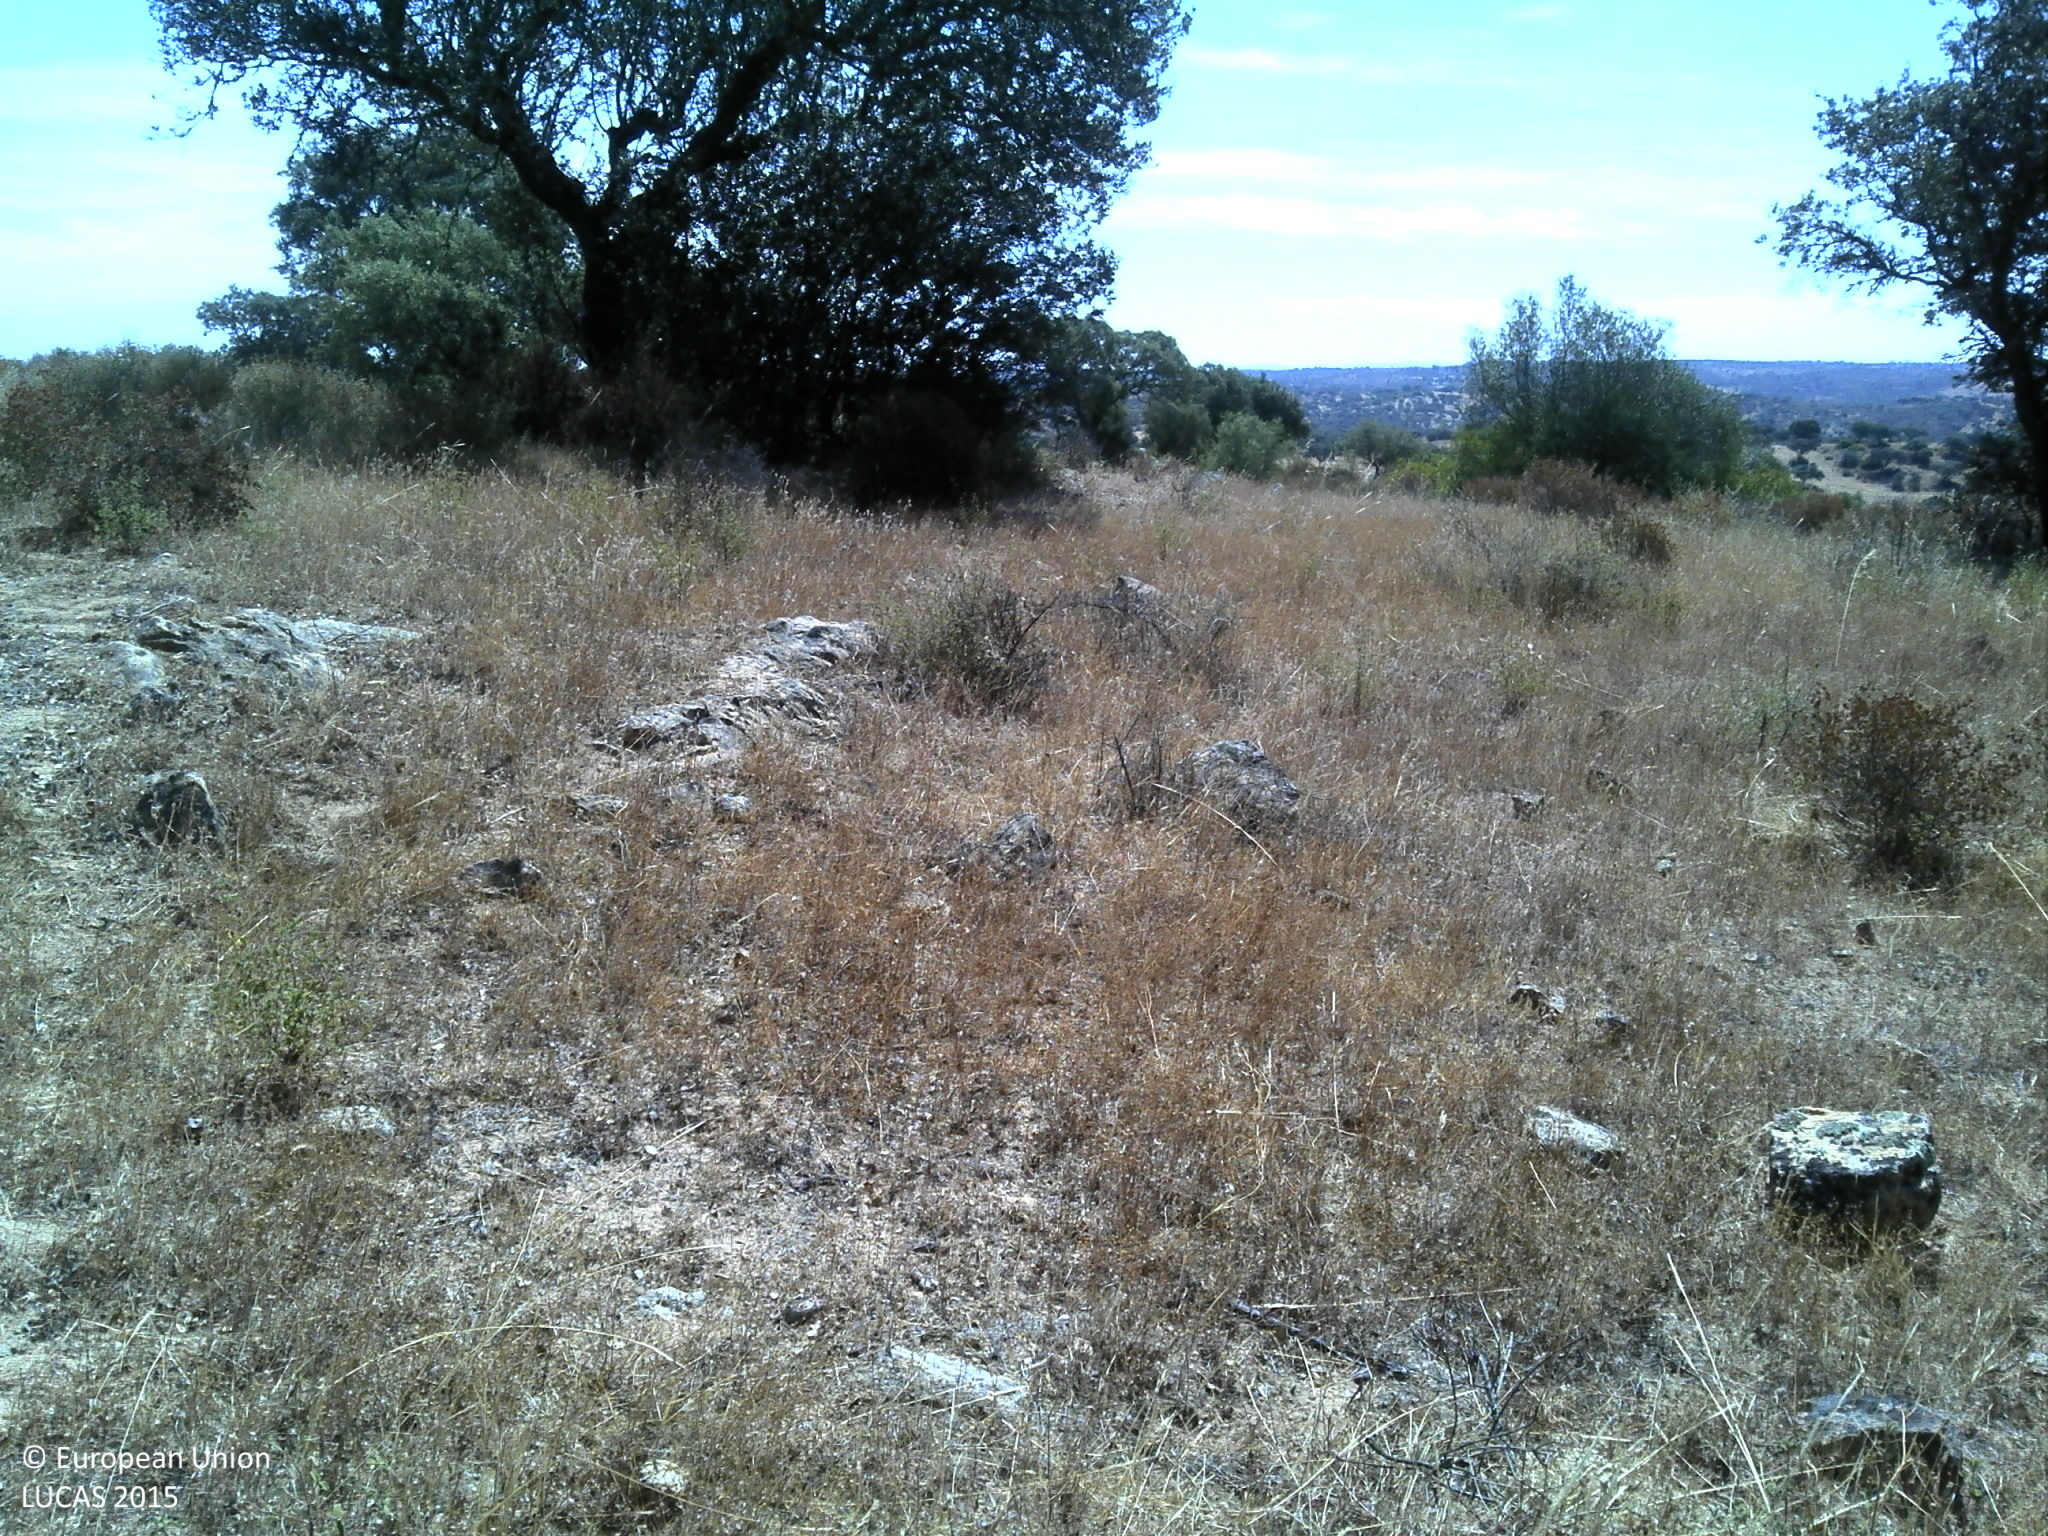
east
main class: Woodland
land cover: Broadleaved woodland
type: broadleaved evergreen forest
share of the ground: 25 - 50 %
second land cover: Grassland without tree/shrub cover
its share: 25 - 50 %
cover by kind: broadleaved forest trees 45 %, herbaceous plants 45 %, unconsolidated bare surface 10 %
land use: Forestry
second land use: Agriculture (excluding fallow land and kitchen gardens)
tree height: < 5 m
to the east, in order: Broadleaved woodland; Grassland without tree/shrub cover; Broadleaved woodland; Olive groves; Rock outcrops; Olive groves; Shrubland with sparse tree cover; Grassland without tree/shrub cover; Rock outcrops; Olive groves; Shrubland without tree cover; Rock outcrops; Shrubland with sparse tree cover
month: June
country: PT
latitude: 37.9051
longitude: -7.4980
